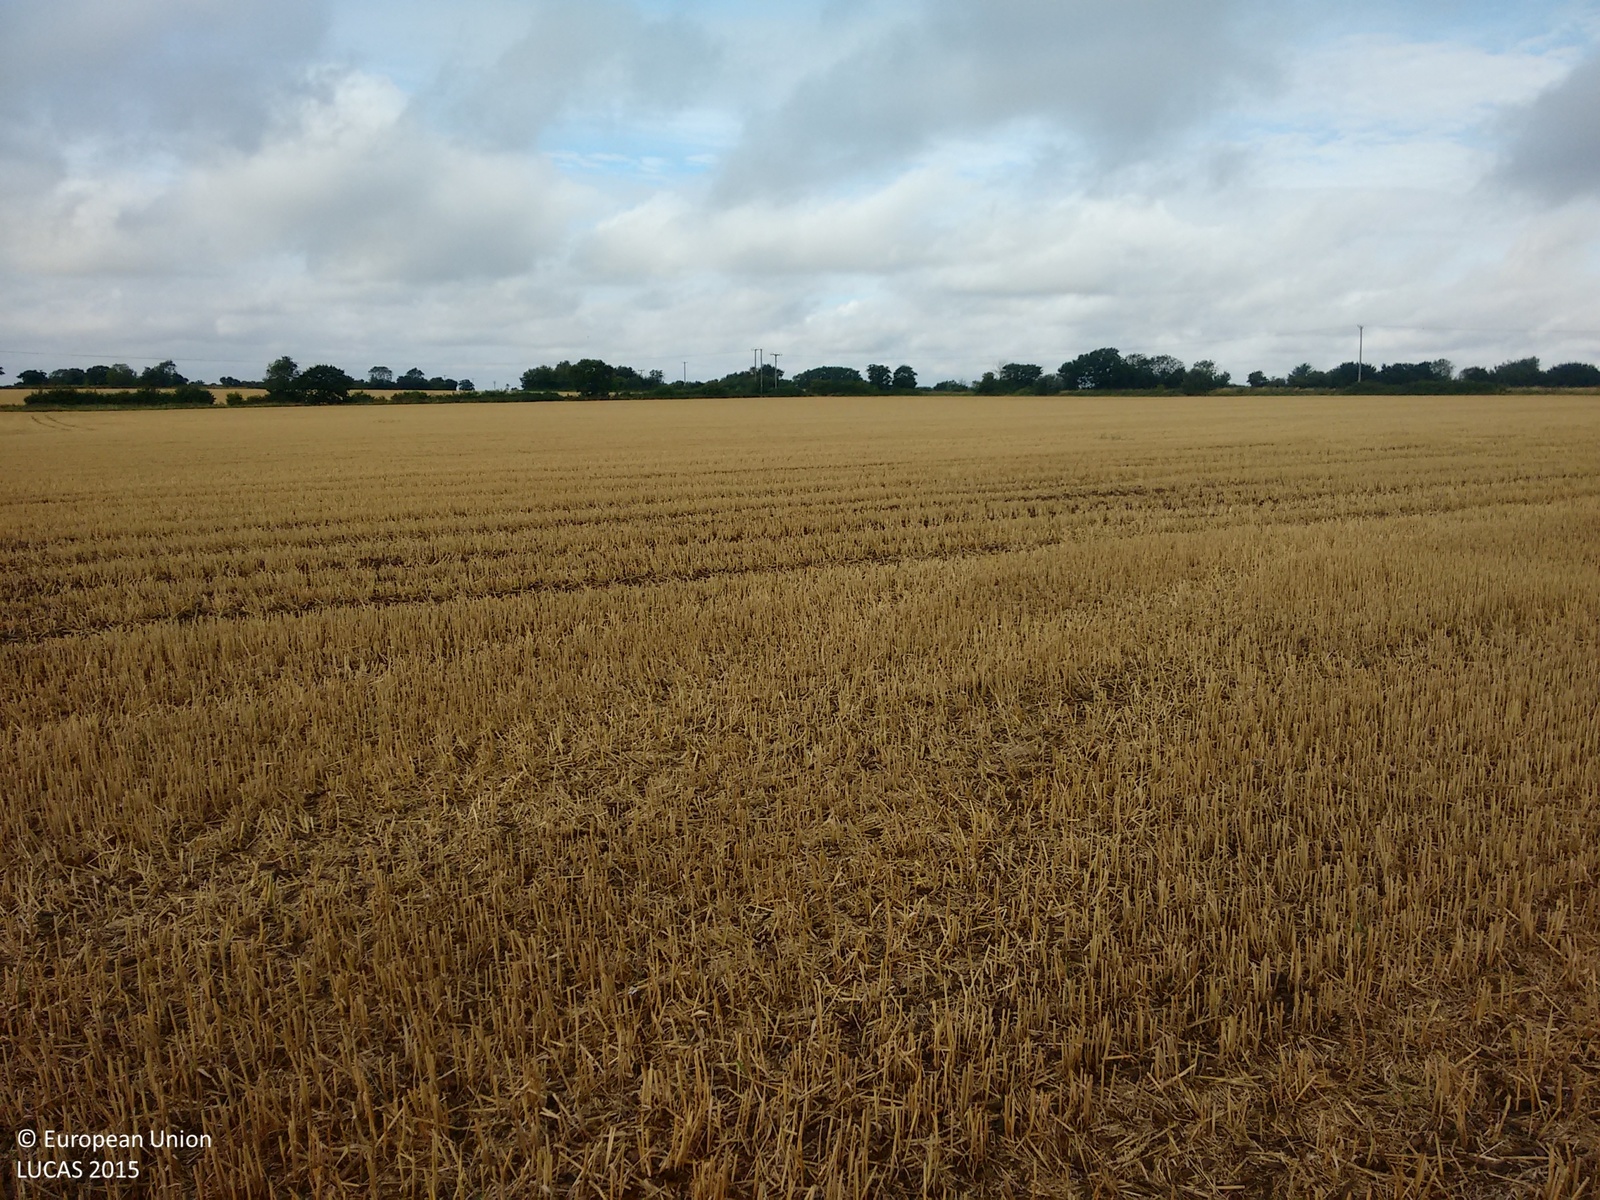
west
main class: Cropland
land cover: Common wheat
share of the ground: > 75 %
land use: Agriculture (excluding fallow land and kitchen gardens)
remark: Harvested field
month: August
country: GB
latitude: 52.1206
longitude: 0.9356
